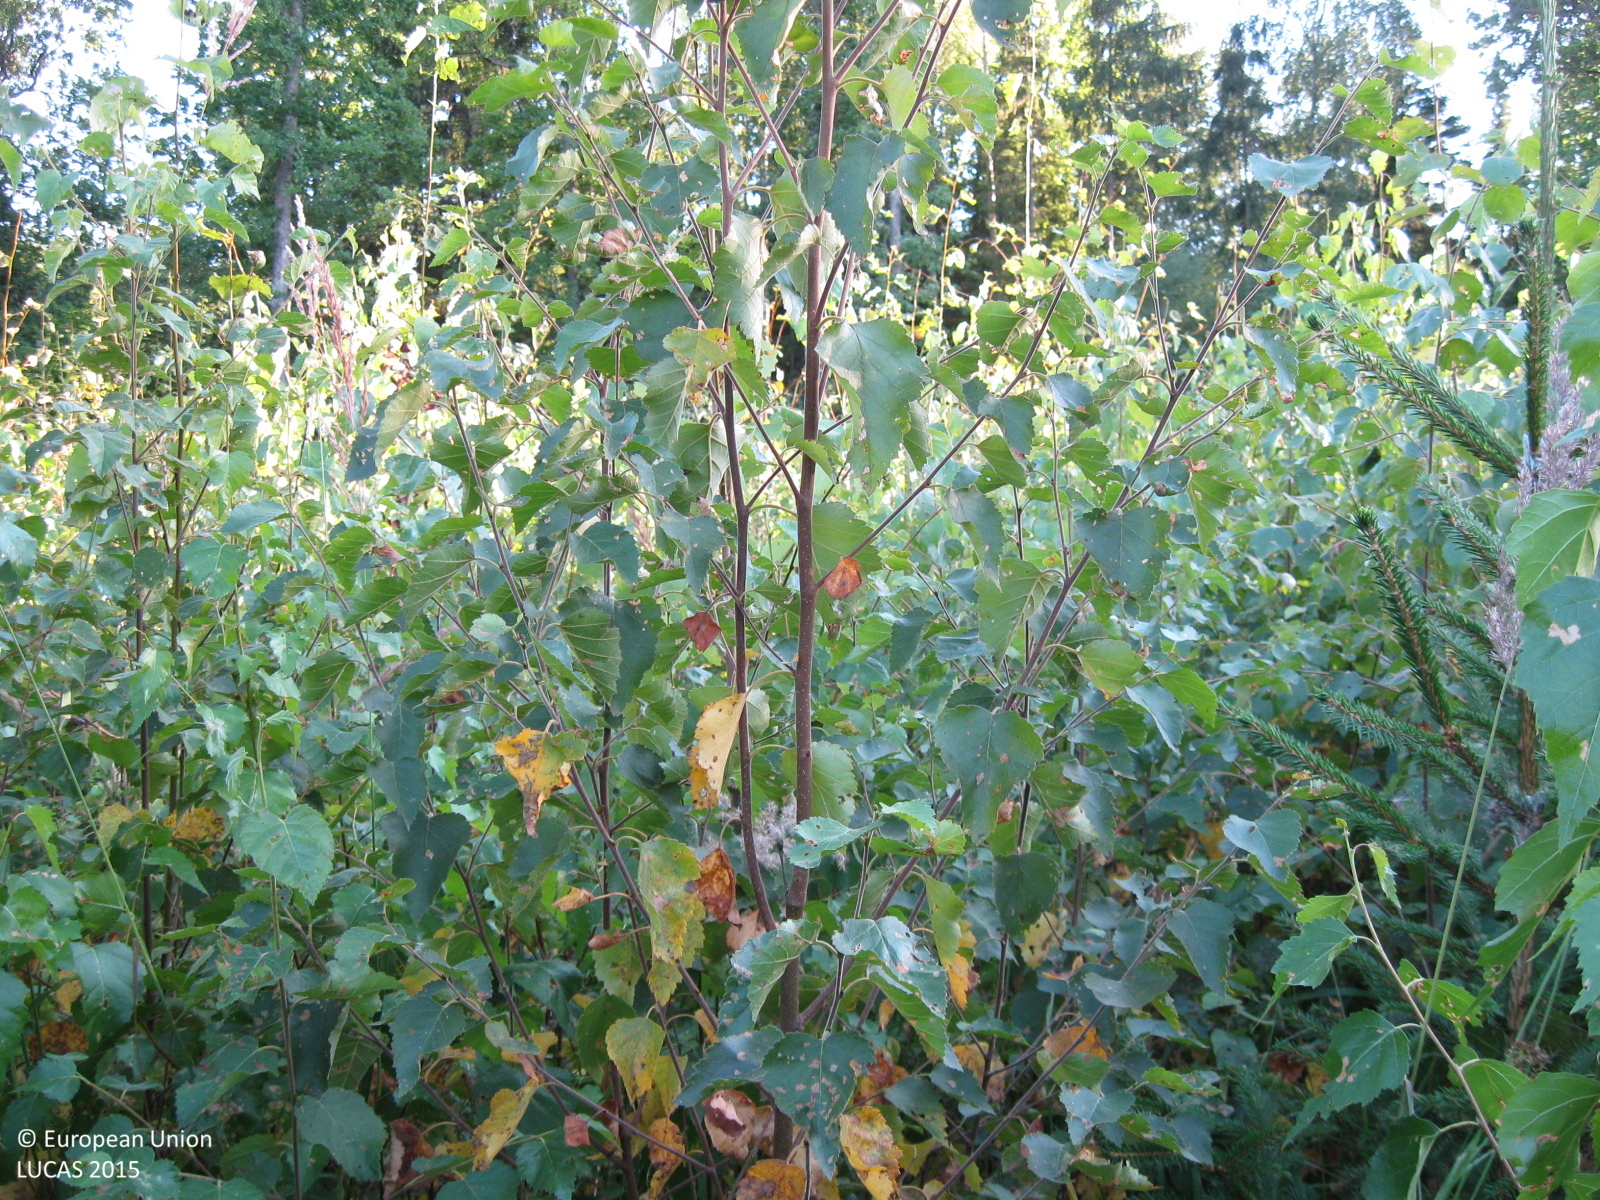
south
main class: Woodland
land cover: Broadleaved woodland
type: non-riverine alder, birch or aspen forest
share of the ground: > 75 %
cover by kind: broadleaved forest trees 90 %, coniferous forest trees 5 %, herbaceous plants 5 %
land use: Forestry
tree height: < 5 m
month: August
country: LT
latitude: 55.3626
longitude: 22.6049
